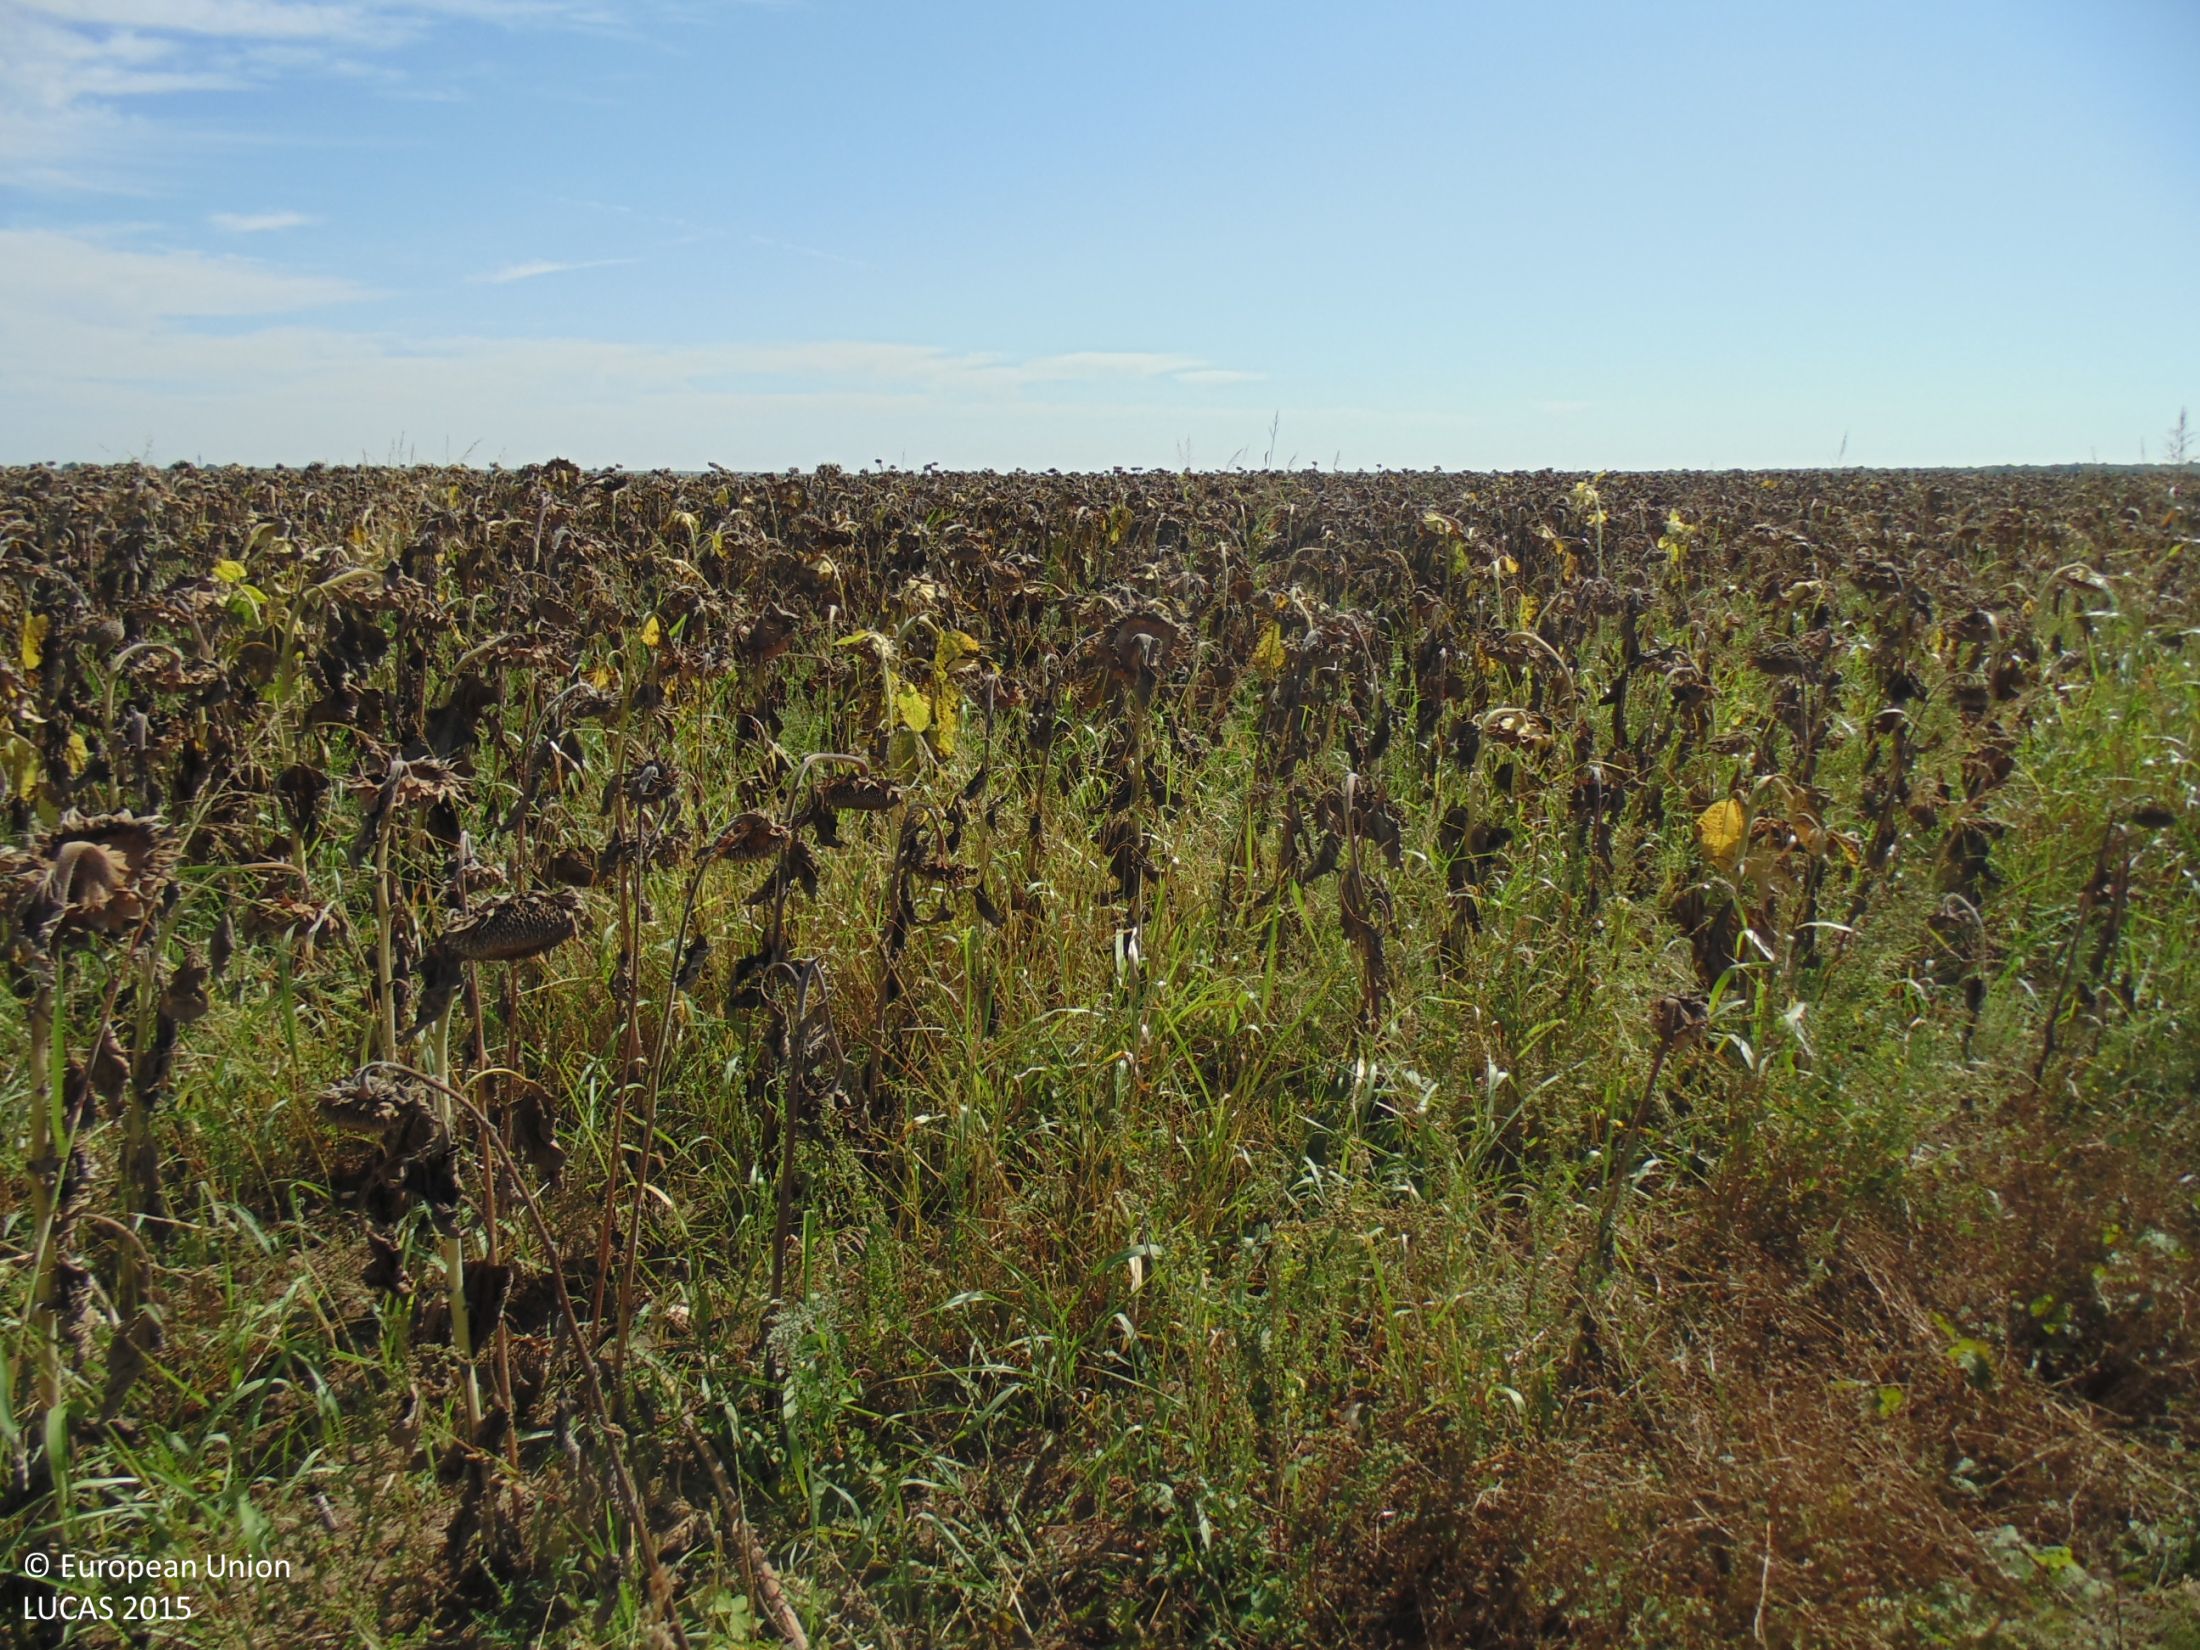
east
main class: Cropland
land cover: Sunflower
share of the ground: > 75 %
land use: Agriculture (excluding fallow land and kitchen gardens)
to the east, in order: Tracks; Grass margins; Sunflower
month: September
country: BG
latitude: 43.8909
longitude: 27.1168
